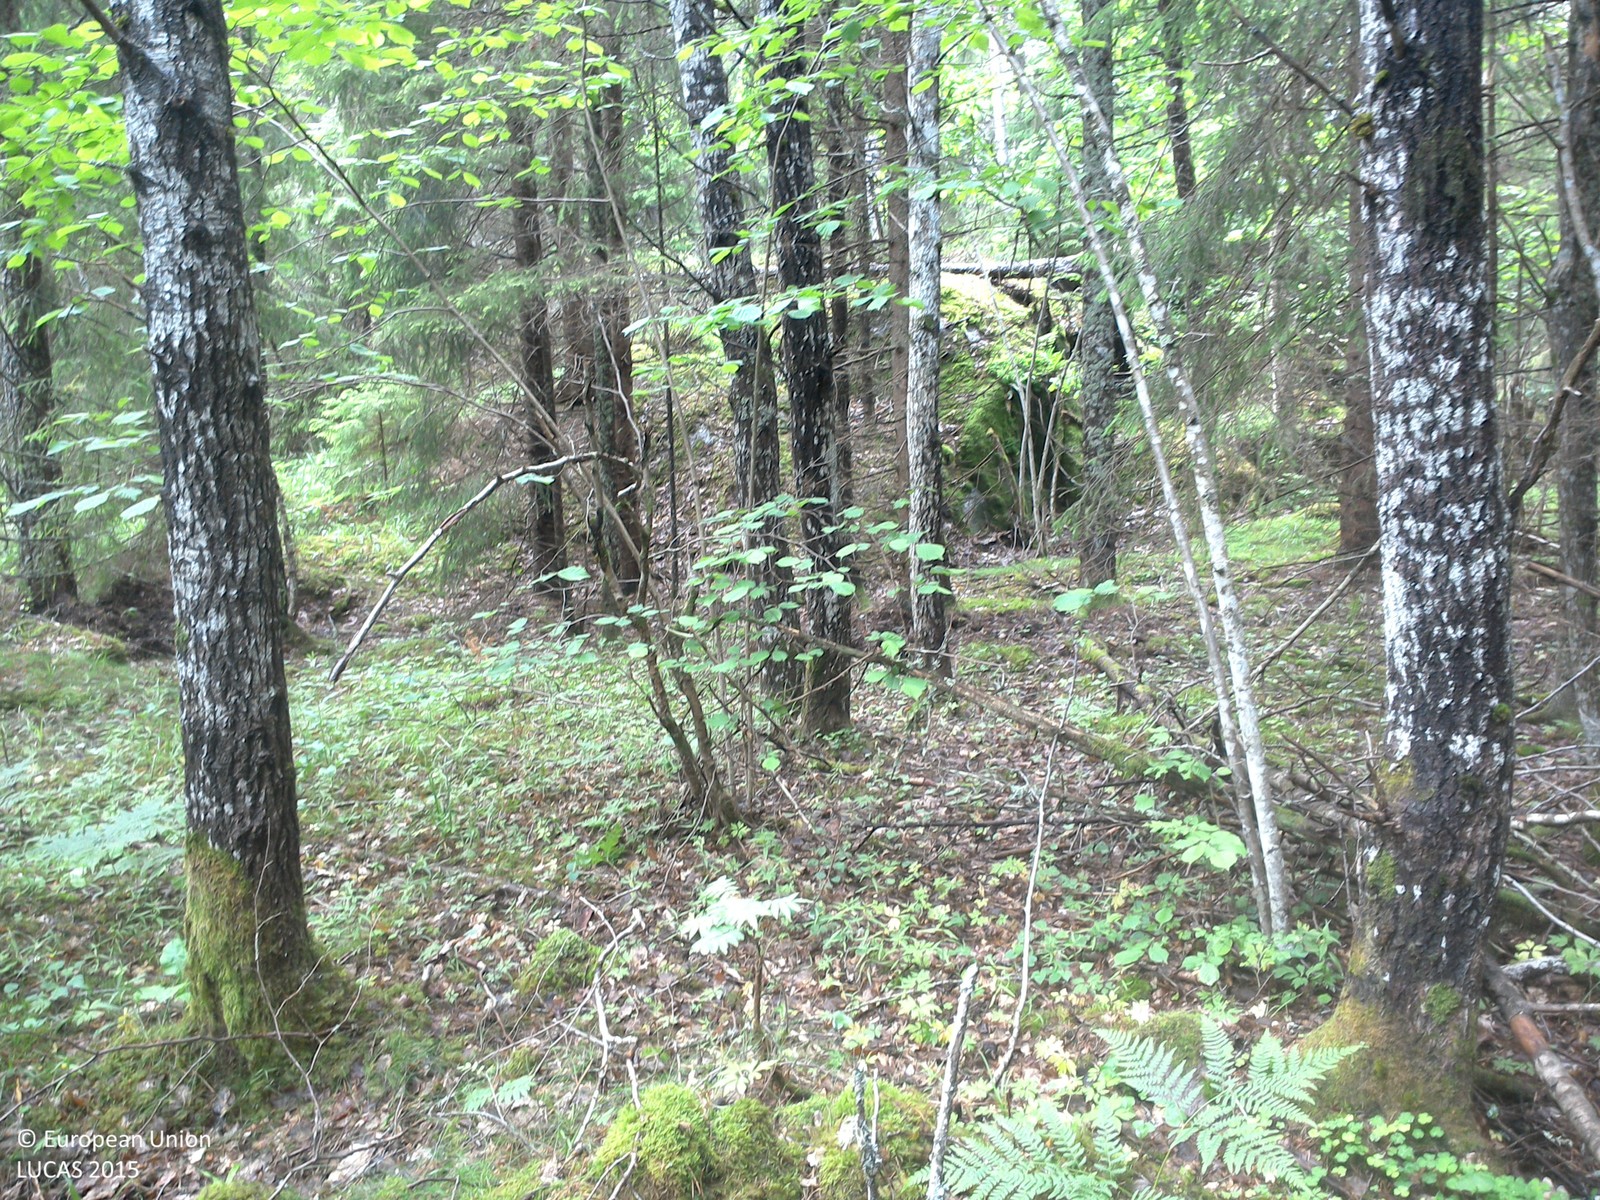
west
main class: Woodland
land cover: Spruce dominated coniferous woodland
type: boreal forest
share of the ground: > 75 %
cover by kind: coniferous forest trees 75 %, lichens and mosses 25 %
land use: Forestry
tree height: > 5 m
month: June
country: SE
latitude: 58.0859
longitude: 15.5752
